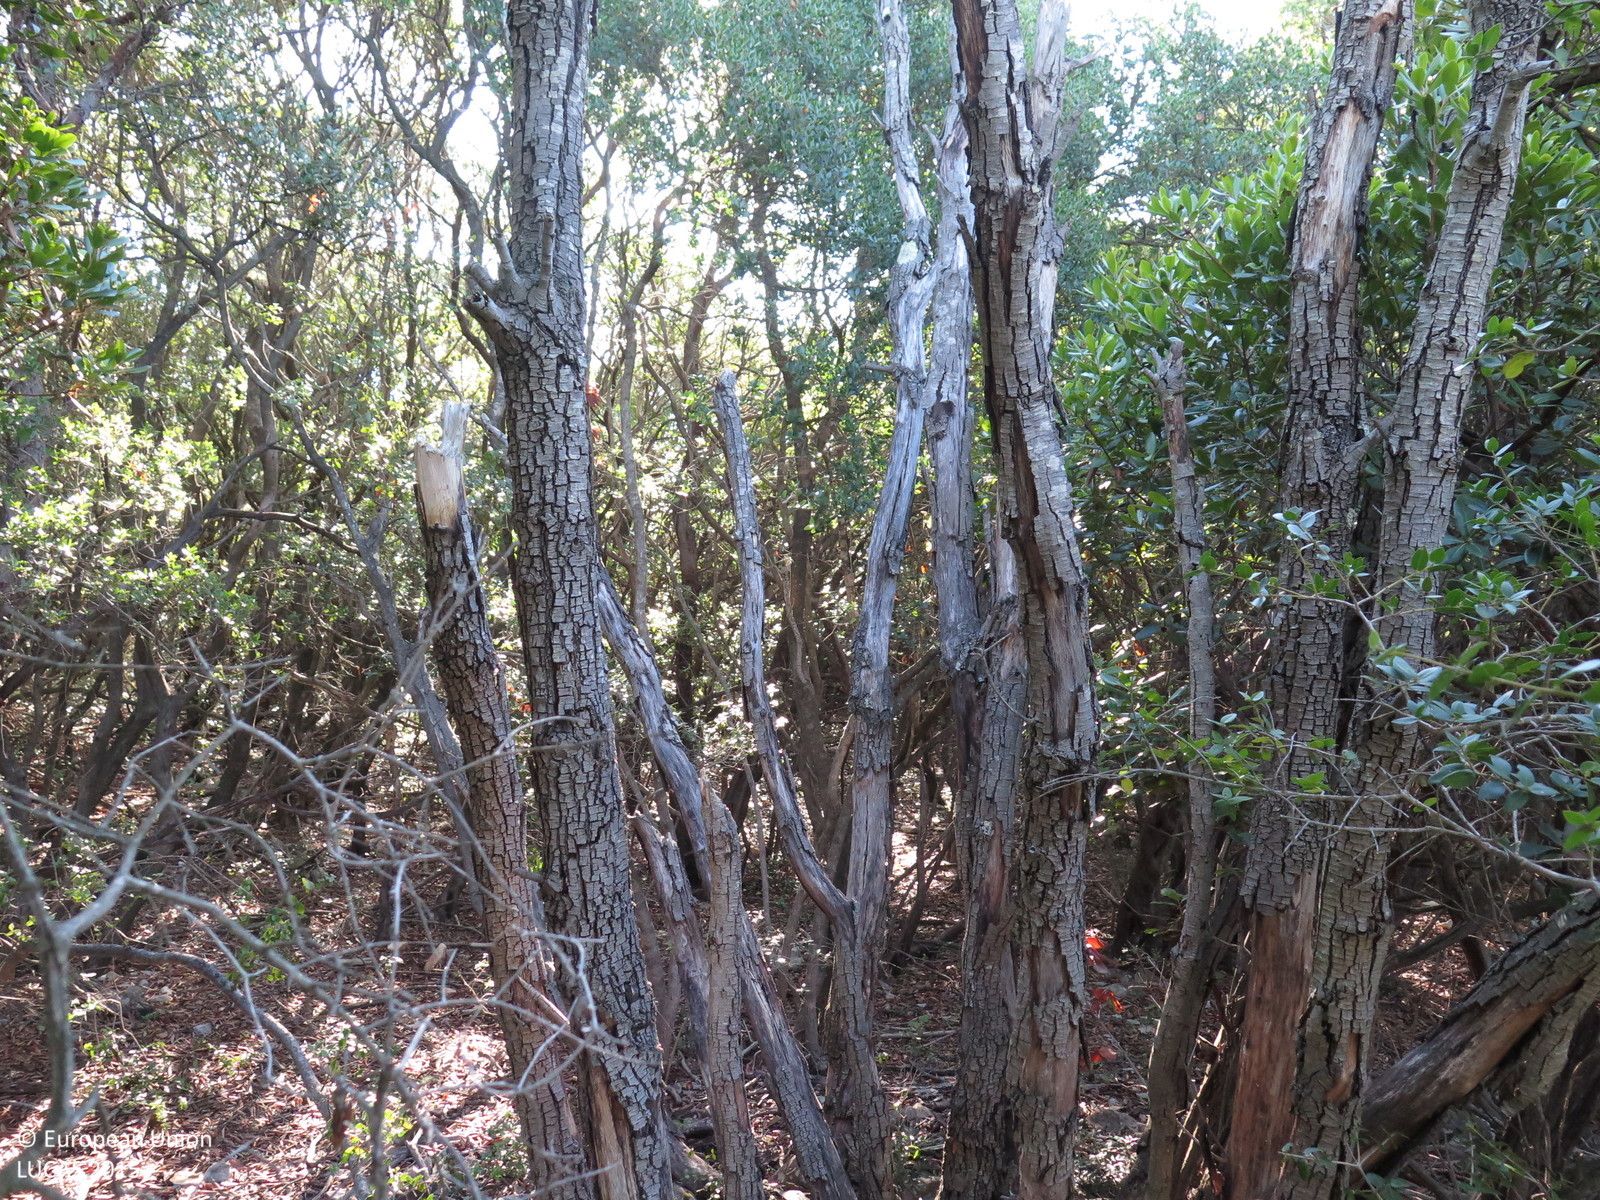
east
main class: Shrubland
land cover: Shrubland with sparse tree cover
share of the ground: > 75 %
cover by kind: shrubs 90 %, broadleaved forest trees 5 %, unconsolidated bare surface 5 %
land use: Semi-natural and natural areas not in use
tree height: > 5 m
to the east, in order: Shrubland with sparse tree cover; Dry stone walls; Shrubland with sparse tree cover; Dry stone walls; Shrubland with sparse tree cover; Dry stone walls; Shrubland with sparse tree cover; Dry stone walls; Shrubland with sparse tree cover; Dry stone walls; Shrubland with sparse tree cover
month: September
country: HR
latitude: 44.5817
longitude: 14.4139
